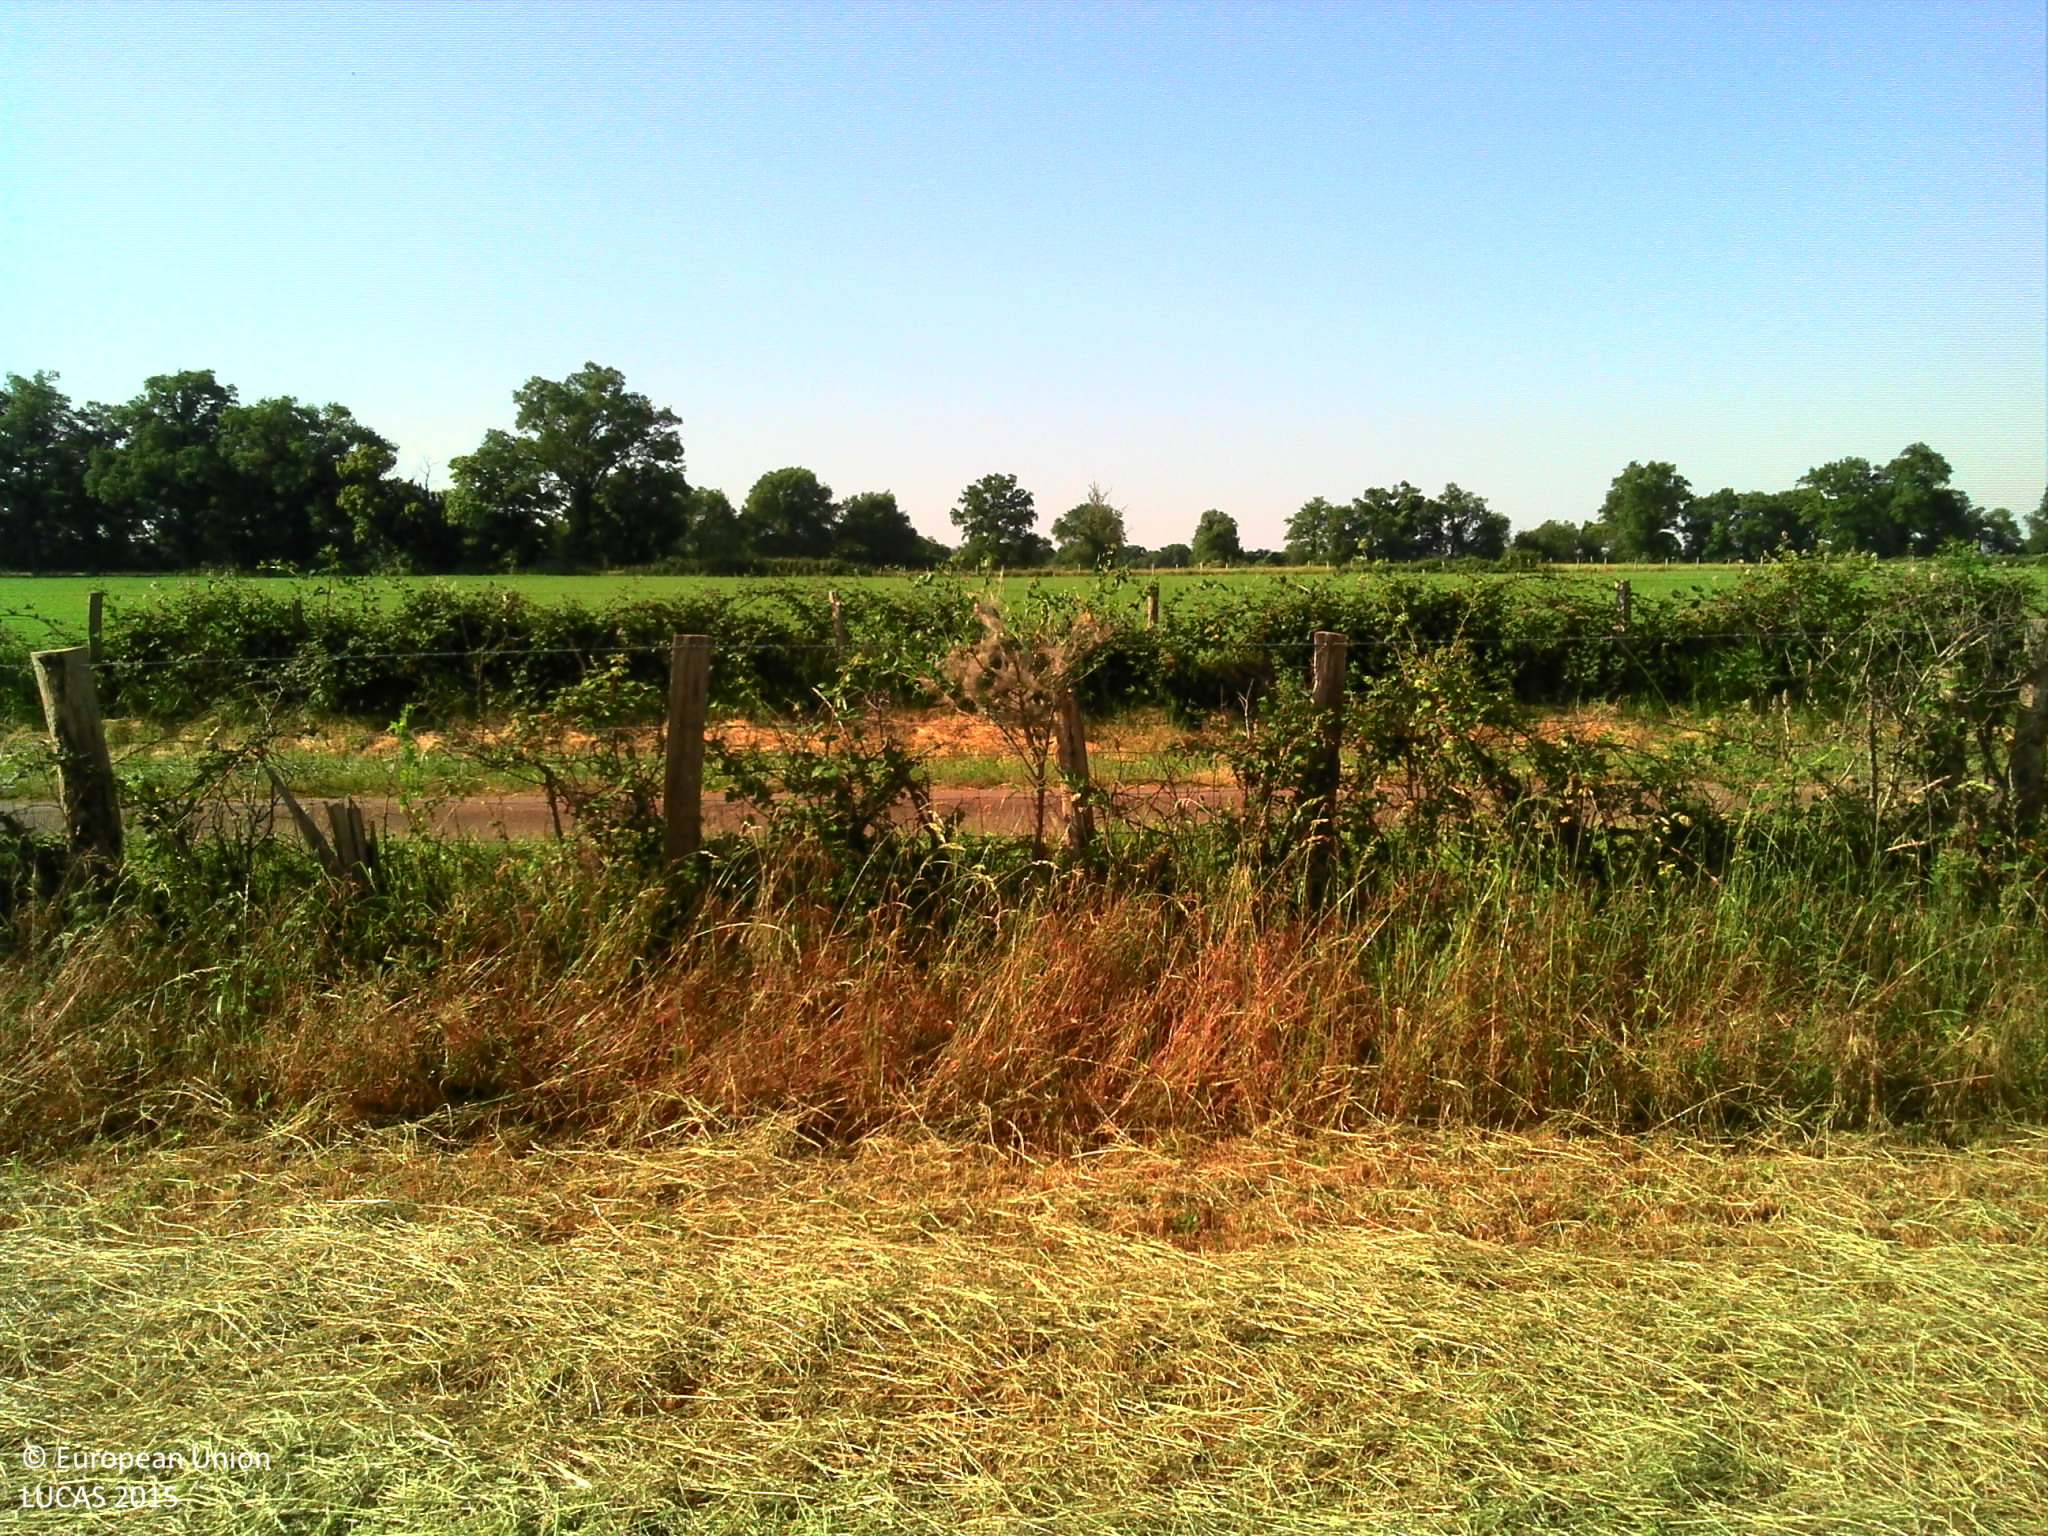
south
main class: Grassland
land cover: Grassland without tree/shrub cover
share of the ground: > 75 %
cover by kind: herbaceous plants 100 %
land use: Agriculture (excluding fallow land and kitchen gardens)
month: June
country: FR
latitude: 46.0421
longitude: 0.5647
